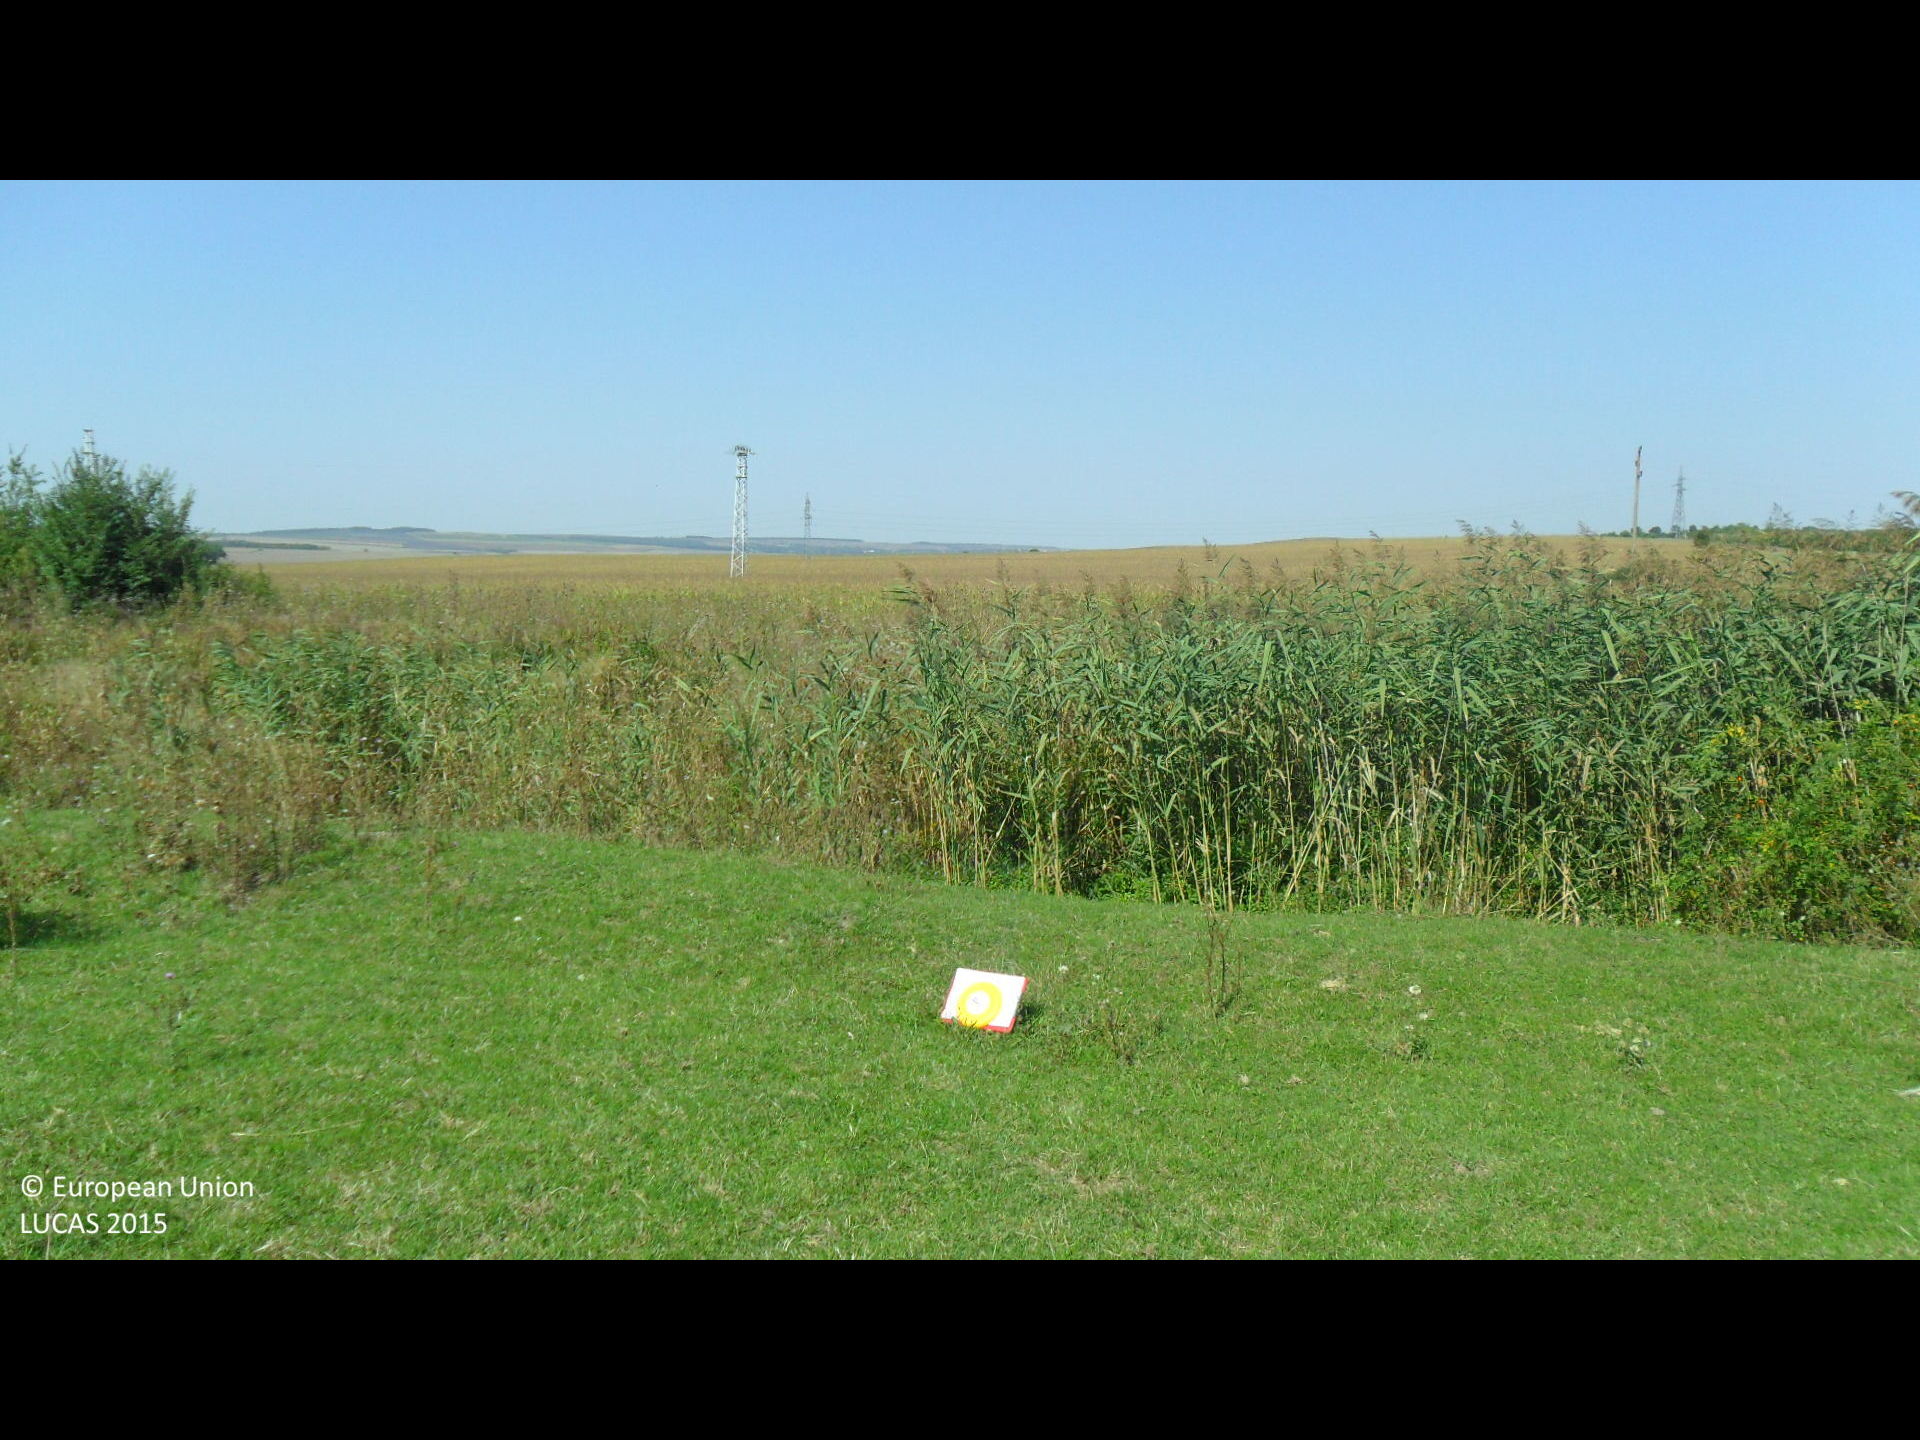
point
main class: Grassland
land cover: Grassland without tree/shrub cover
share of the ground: > 75 %
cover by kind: herbaceous plants 100 %
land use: Agriculture (excluding fallow land and kitchen gardens)
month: August
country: BG
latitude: 43.2733
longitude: 26.6282
